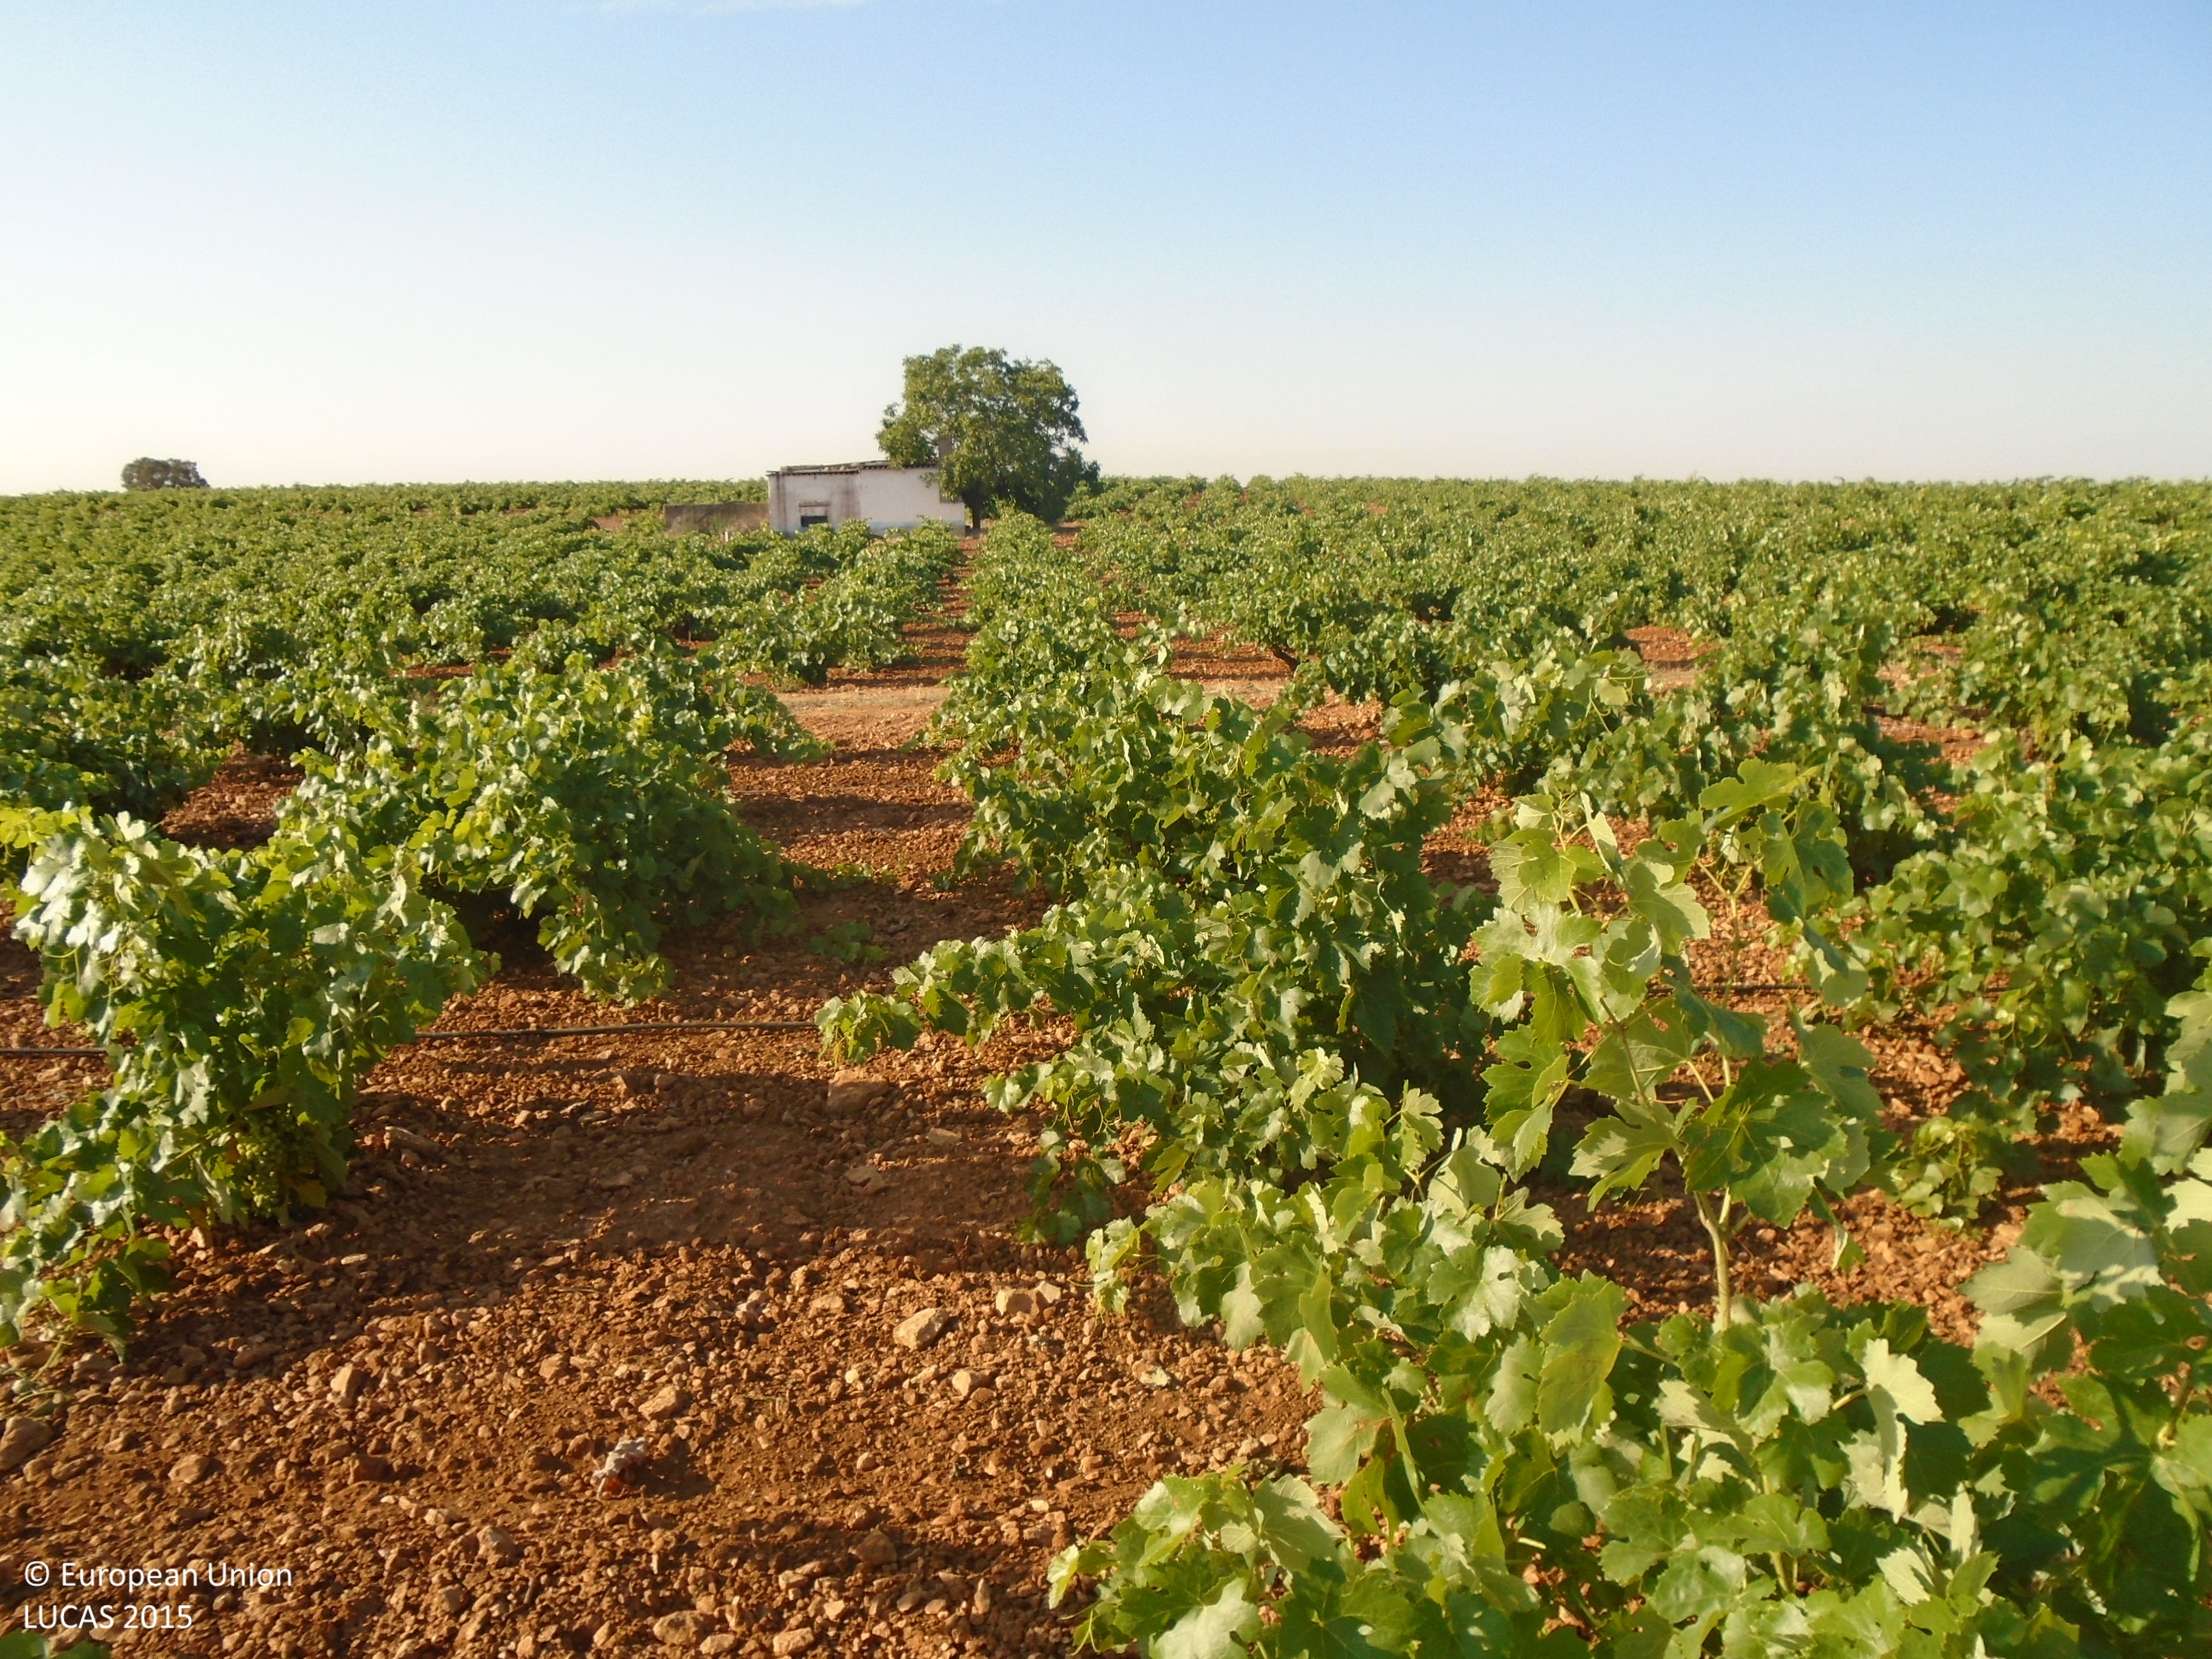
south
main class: Cropland
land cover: Vineyards
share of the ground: 25 - 50 %
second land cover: Other bare soil
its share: > 75 %
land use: Agriculture (excluding fallow land and kitchen gardens)
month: June
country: ES
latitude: 39.2599
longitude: -3.4741
